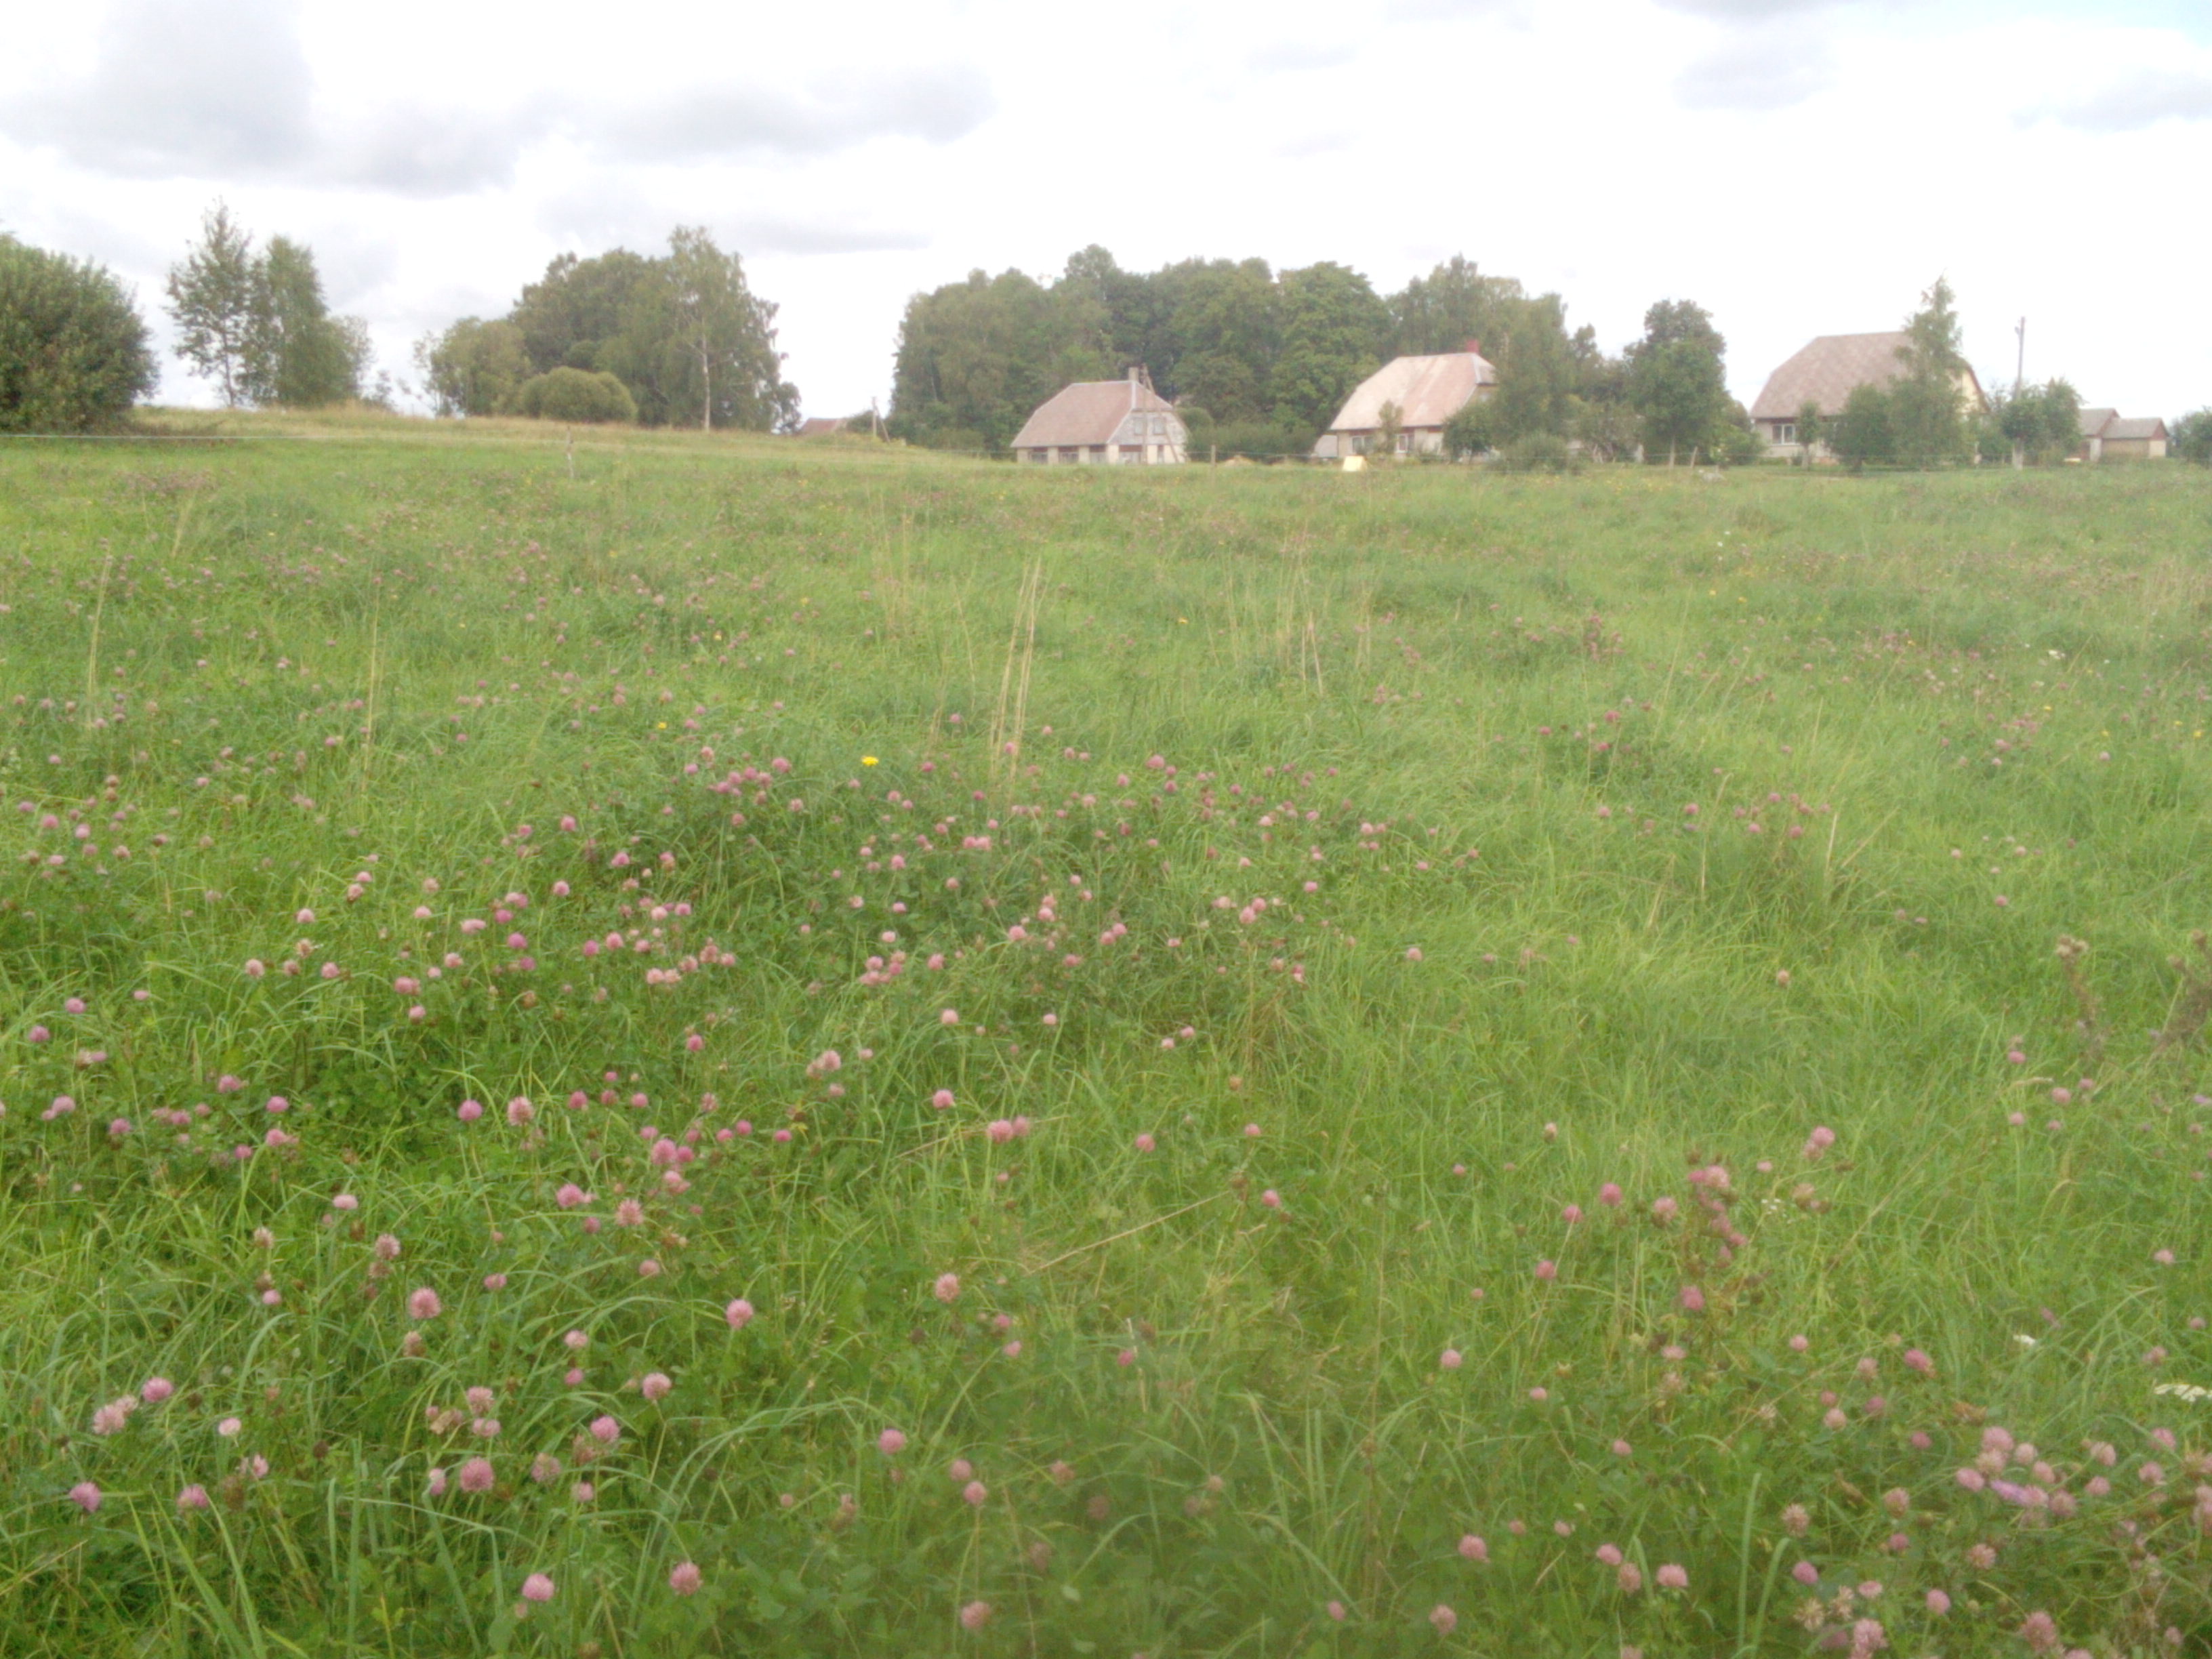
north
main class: Grassland
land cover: Grassland without tree/shrub cover
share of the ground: > 75 %
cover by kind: herbaceous plants 100 %
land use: Agriculture (excluding fallow land and kitchen gardens)
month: September
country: LT
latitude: 55.8559
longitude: 22.4071
